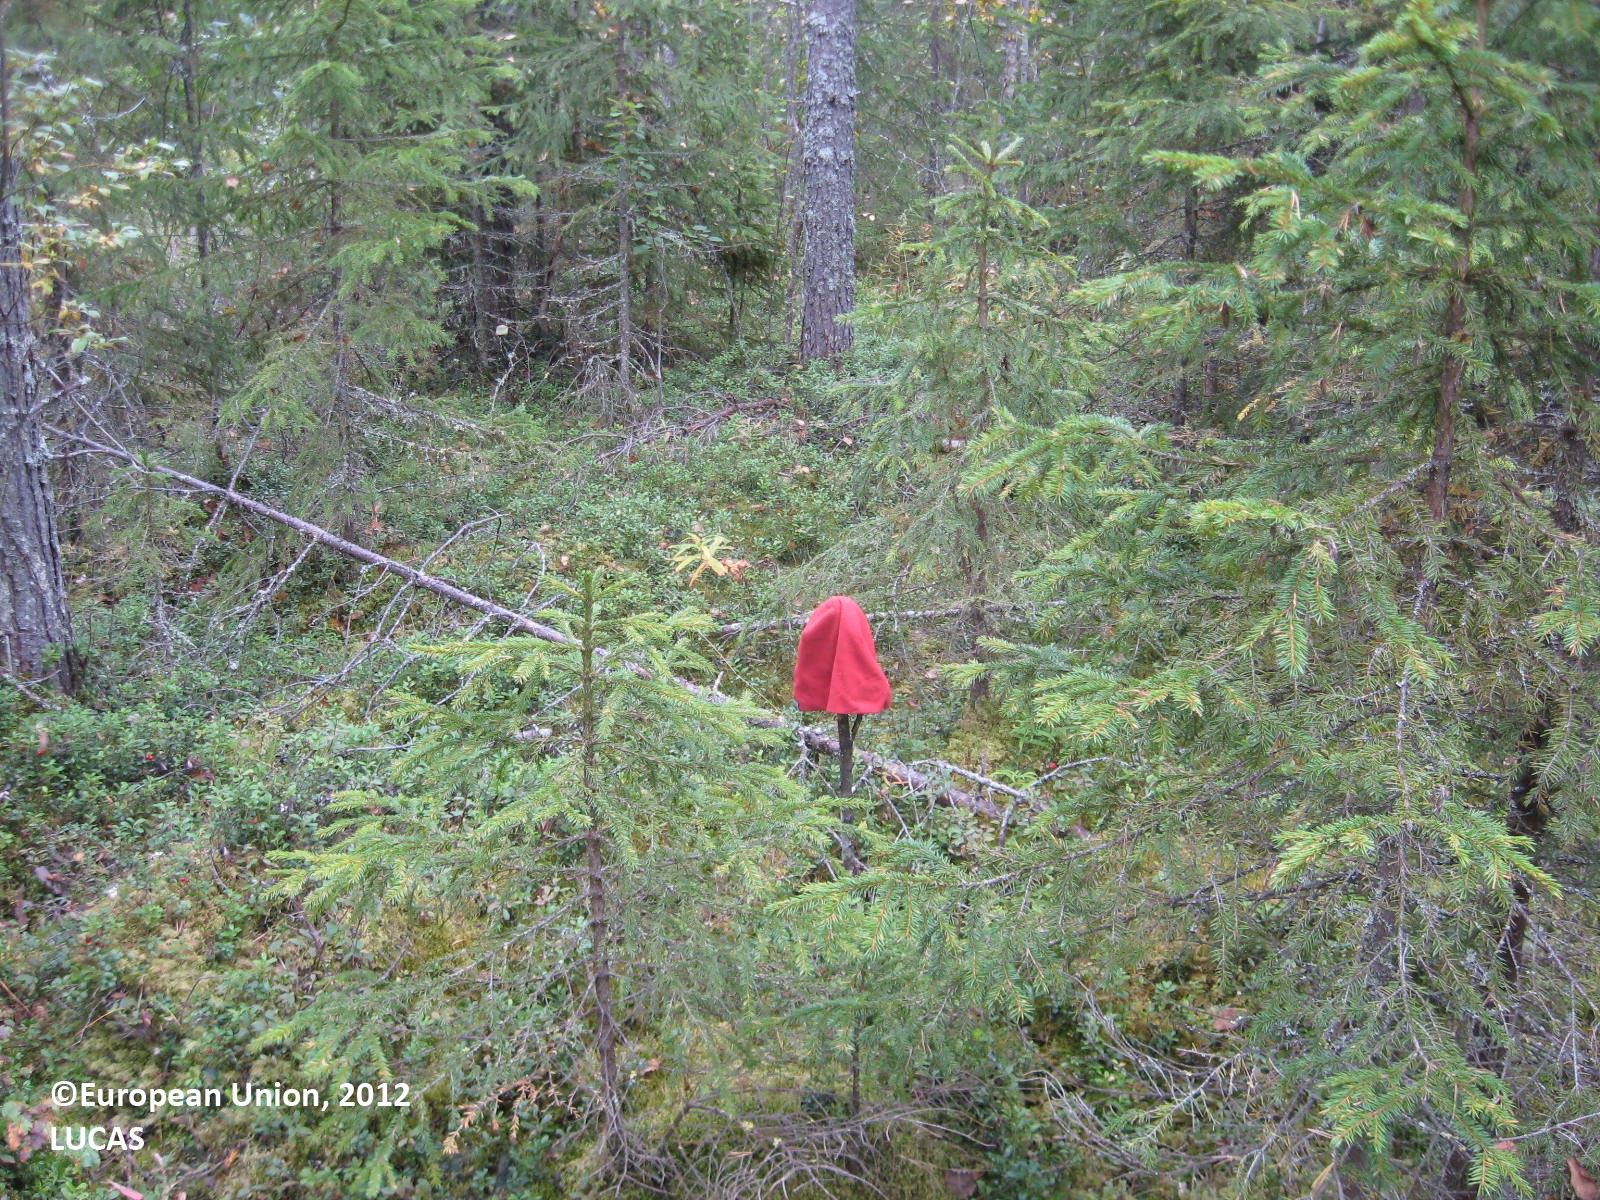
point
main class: Woodland
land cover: Pine dominated coniferous woodland
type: boreal forest
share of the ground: > 75 %
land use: Forestry
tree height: > 5 m
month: September
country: FI
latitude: 64.0196
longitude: 28.3670
